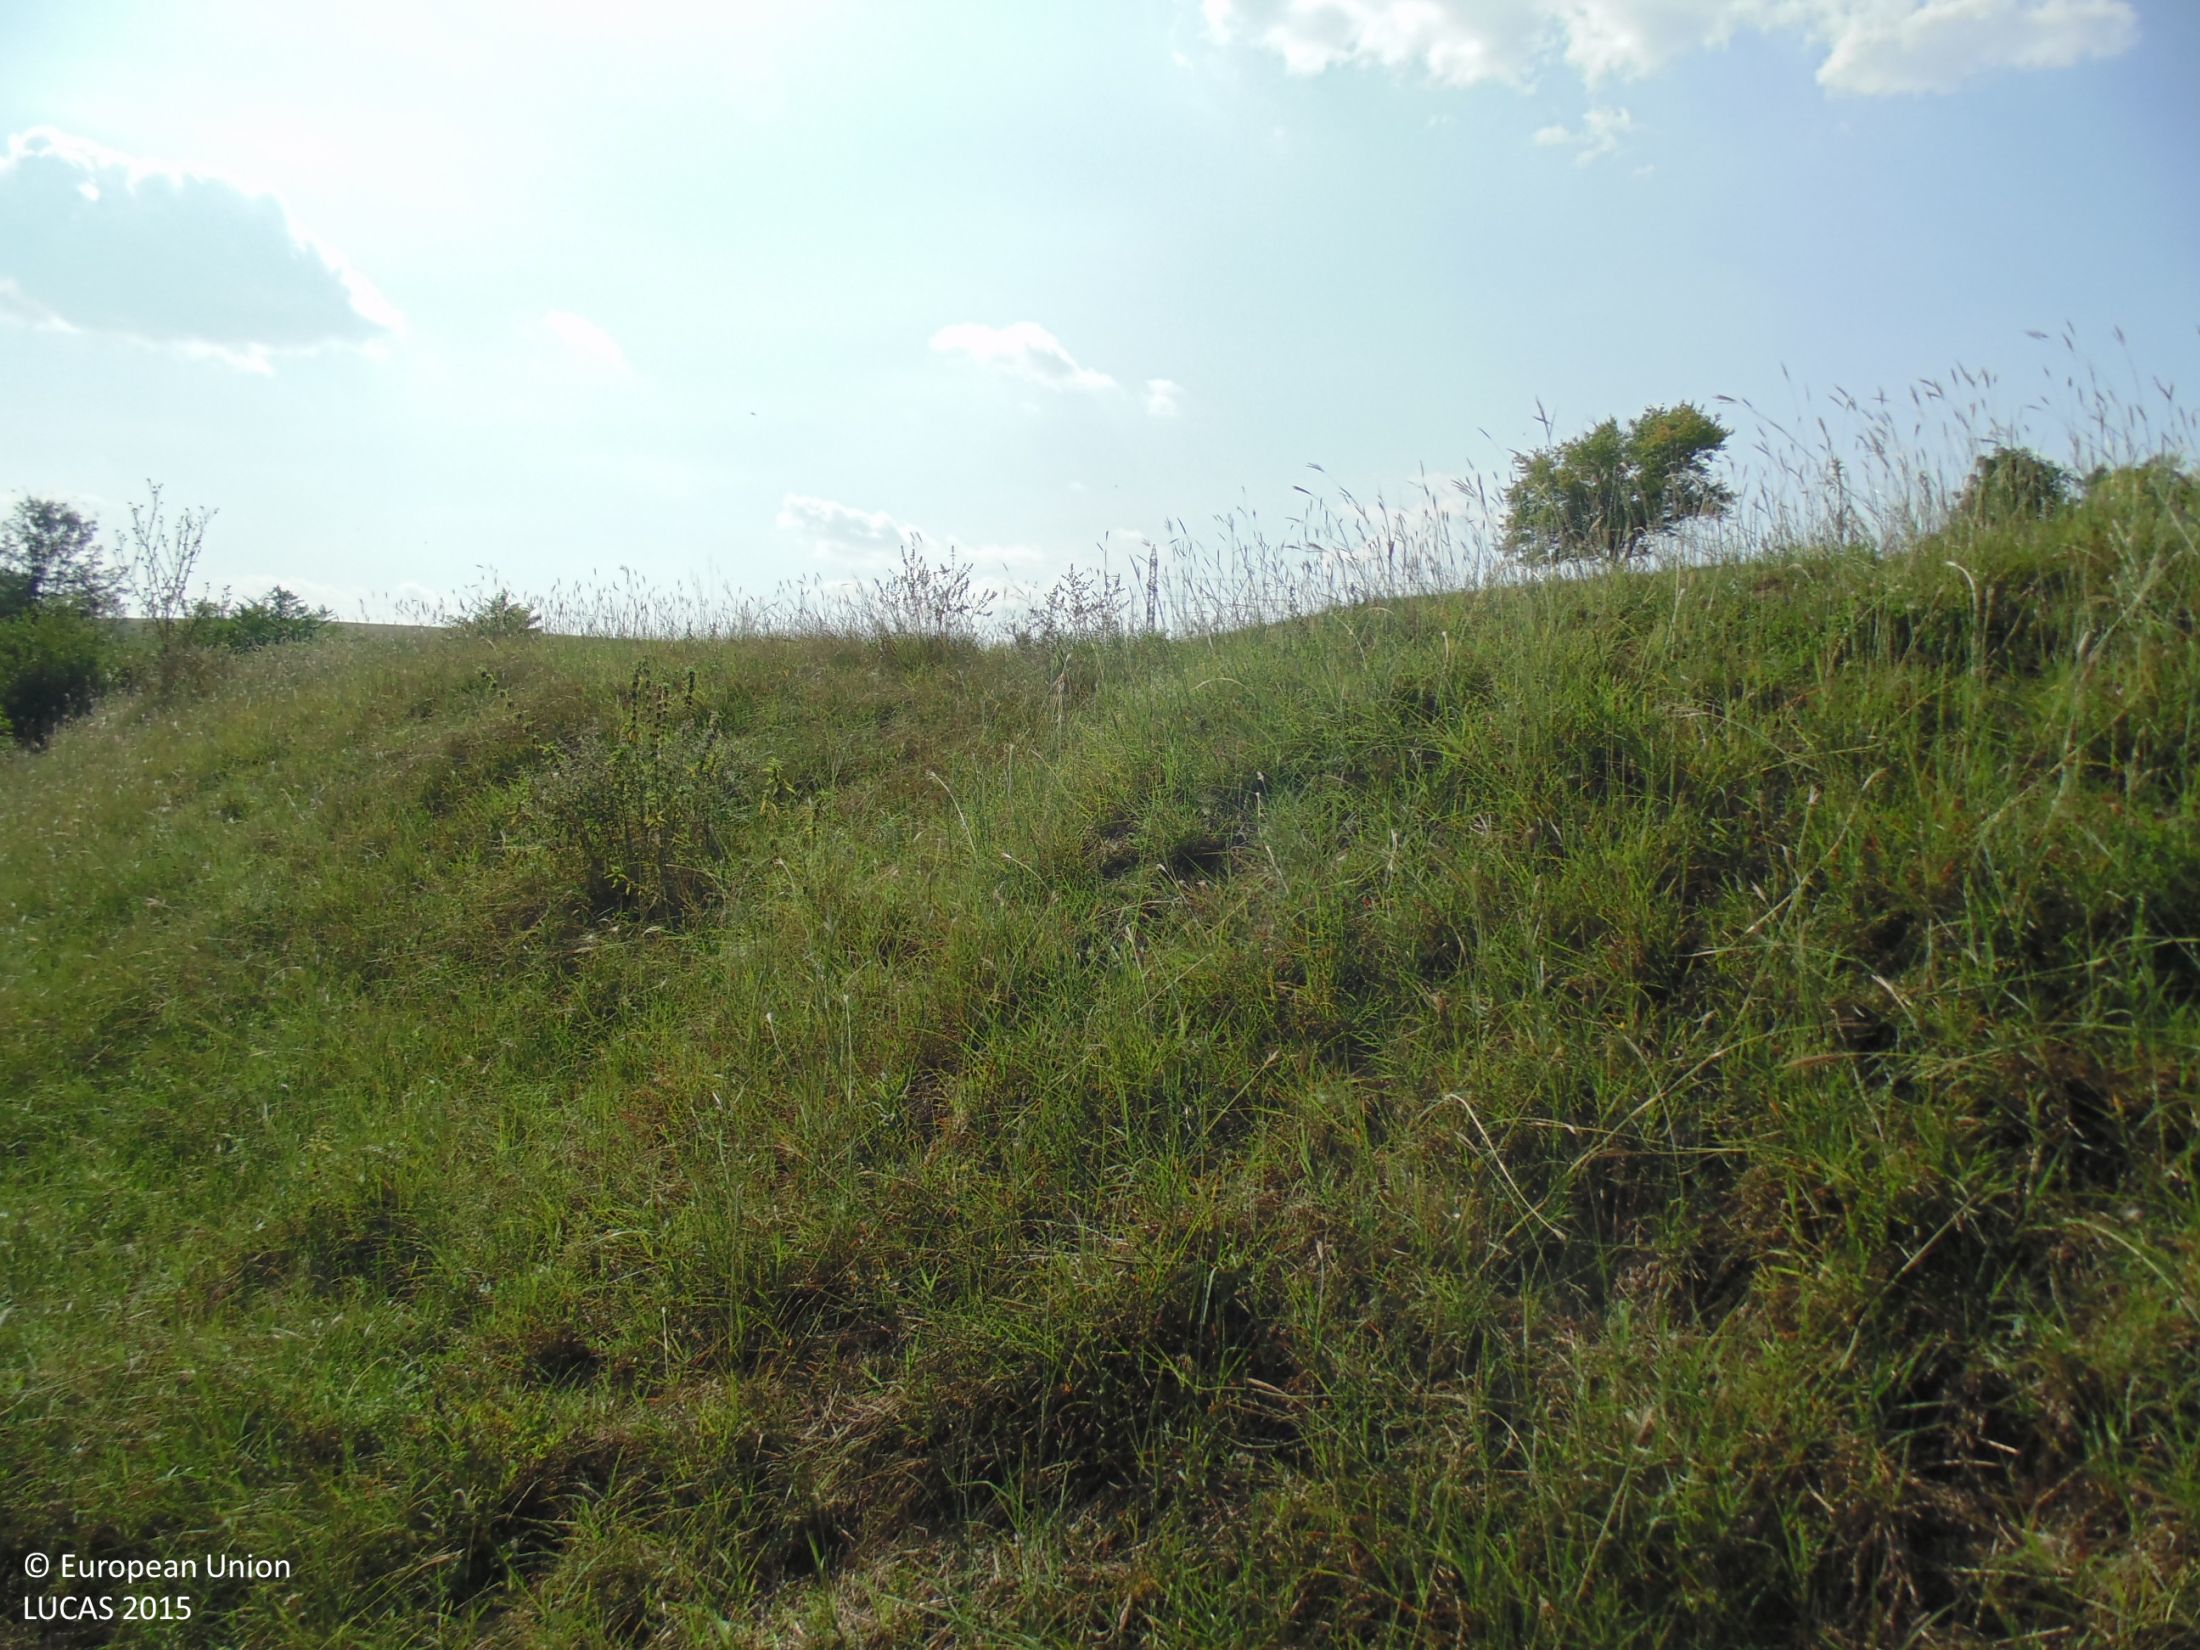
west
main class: Grassland
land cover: Grassland without tree/shrub cover
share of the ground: > 75 %
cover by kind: herbaceous plants 100 %
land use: Agriculture (excluding fallow land and kitchen gardens)
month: August
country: BG
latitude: 43.9496
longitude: 27.3141
